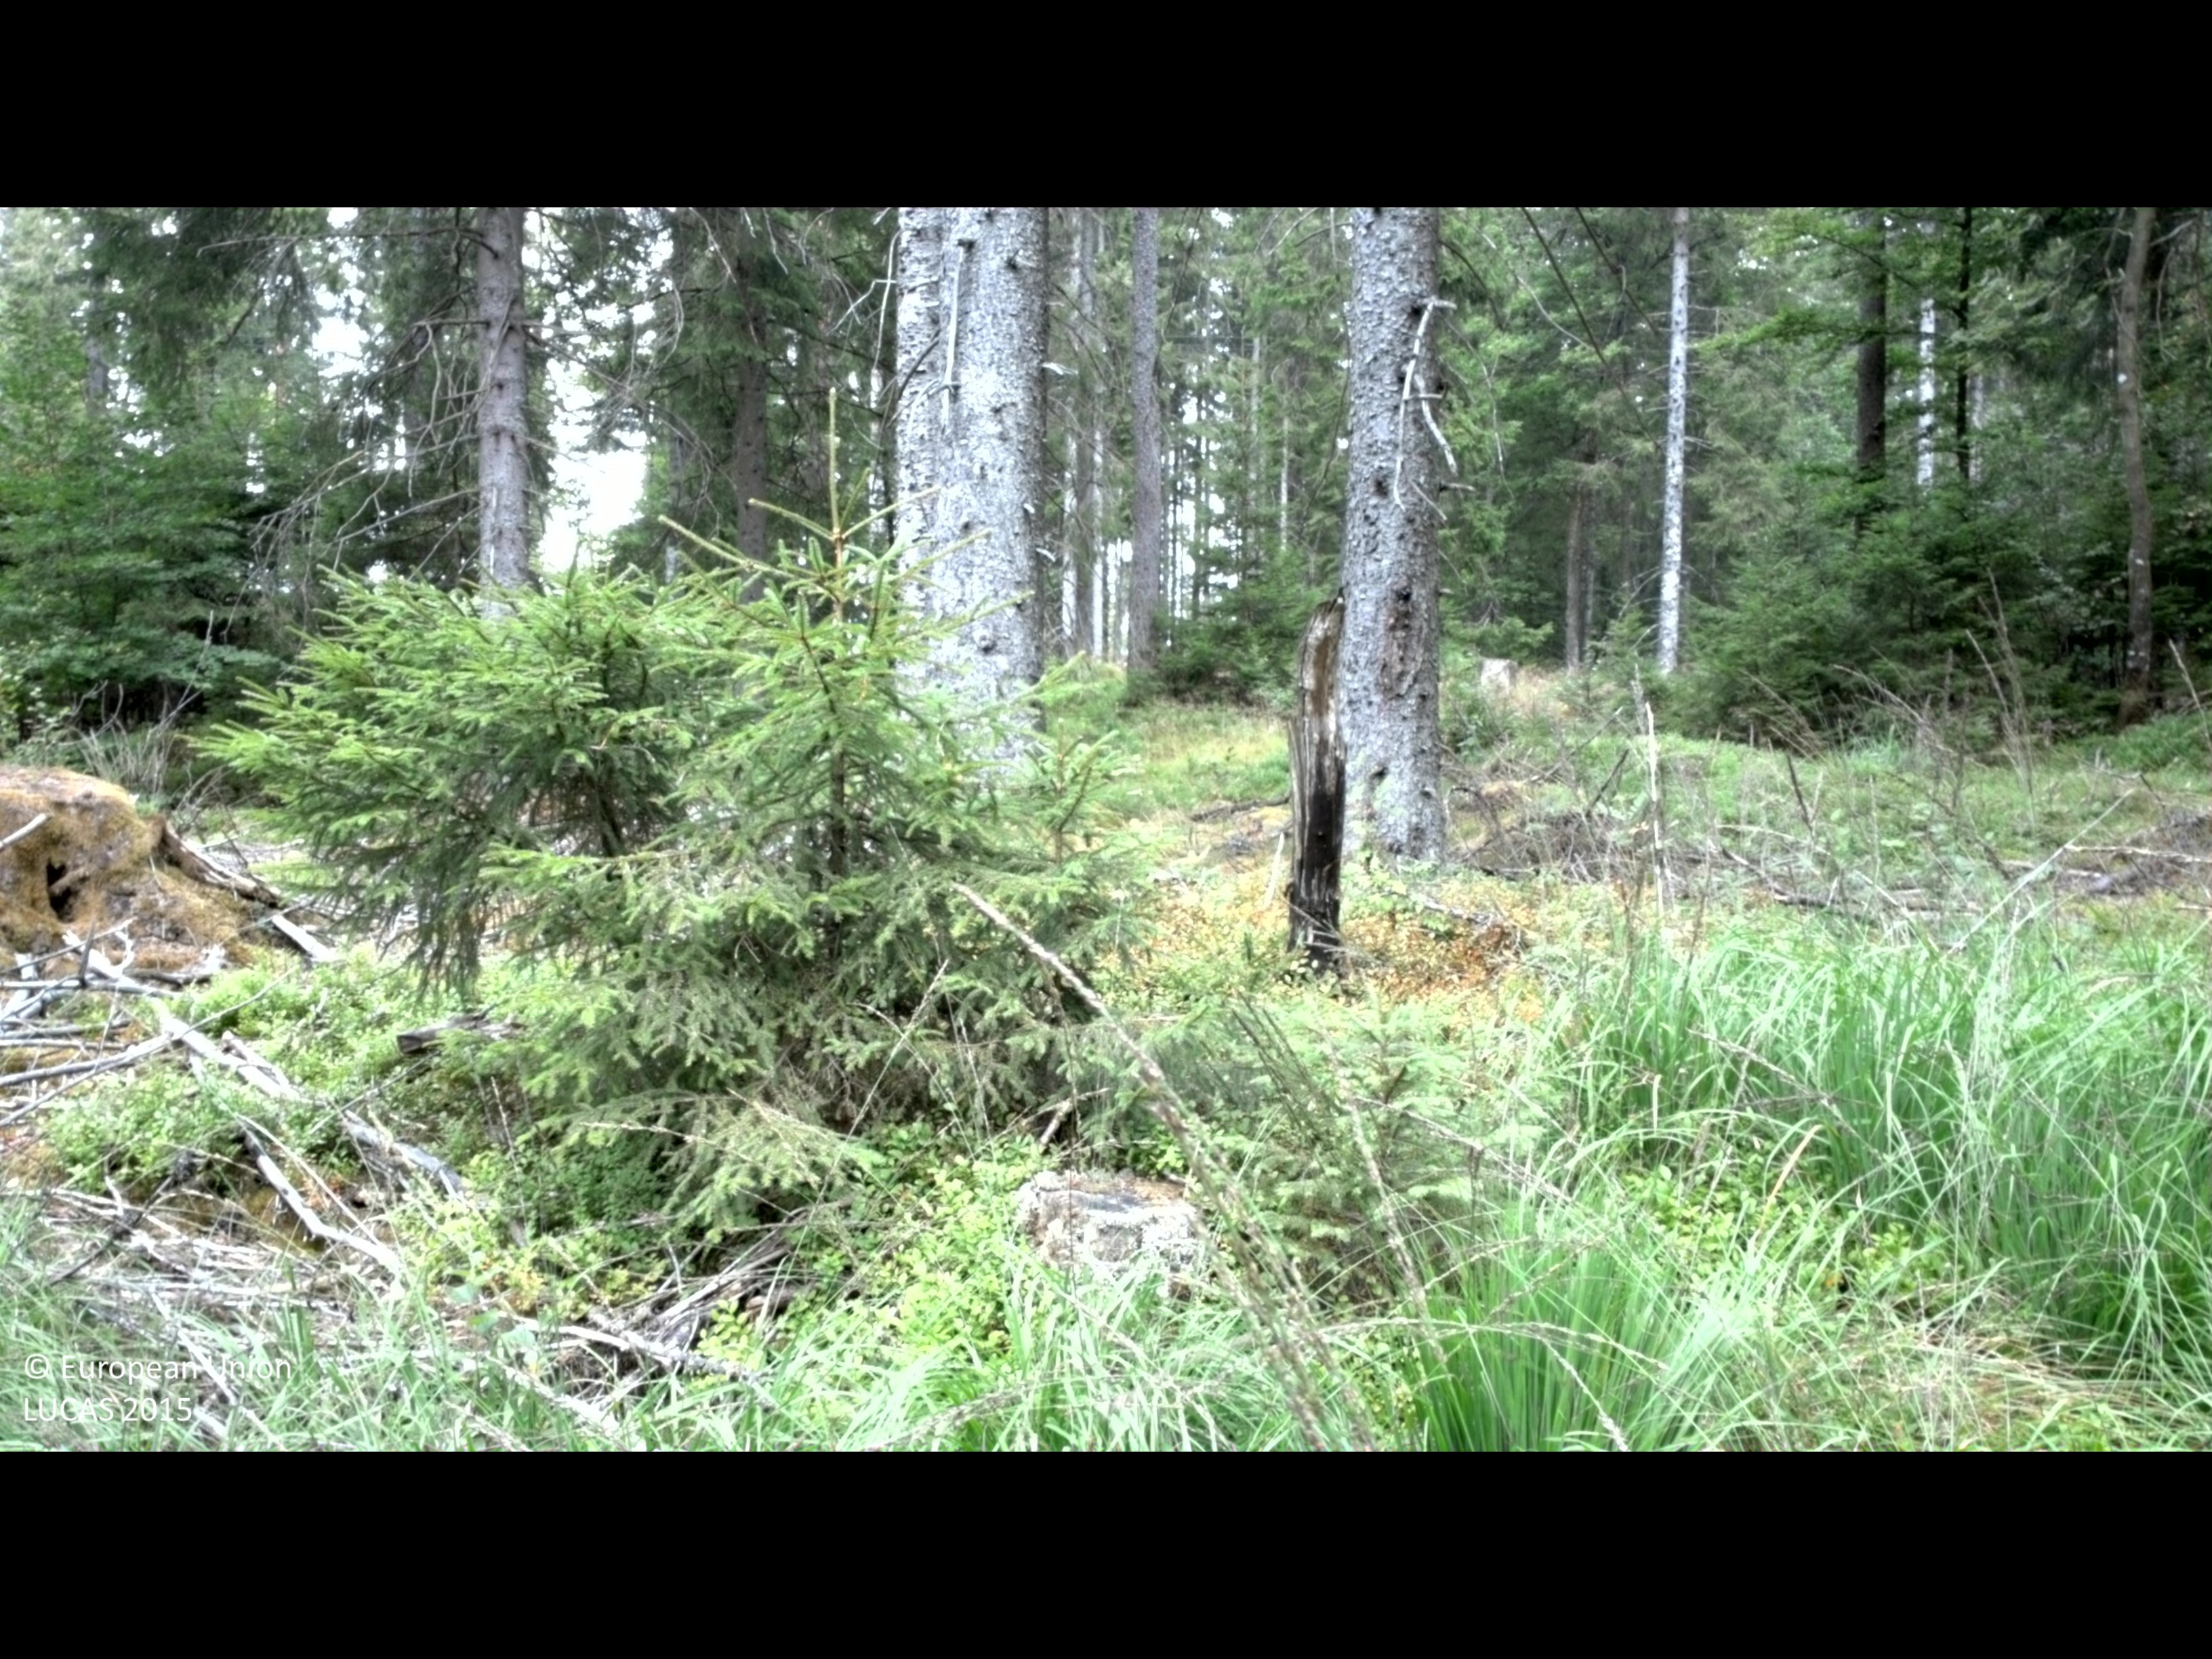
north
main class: Grassland
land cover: Grassland with sparse tree/shrub cover
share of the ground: > 75 %
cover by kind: herbaceous plants 90 %, broadleaved forest trees 5 %, shrubs 5 %
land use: Forestry
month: August
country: SE
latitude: 56.8490
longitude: 13.2266
